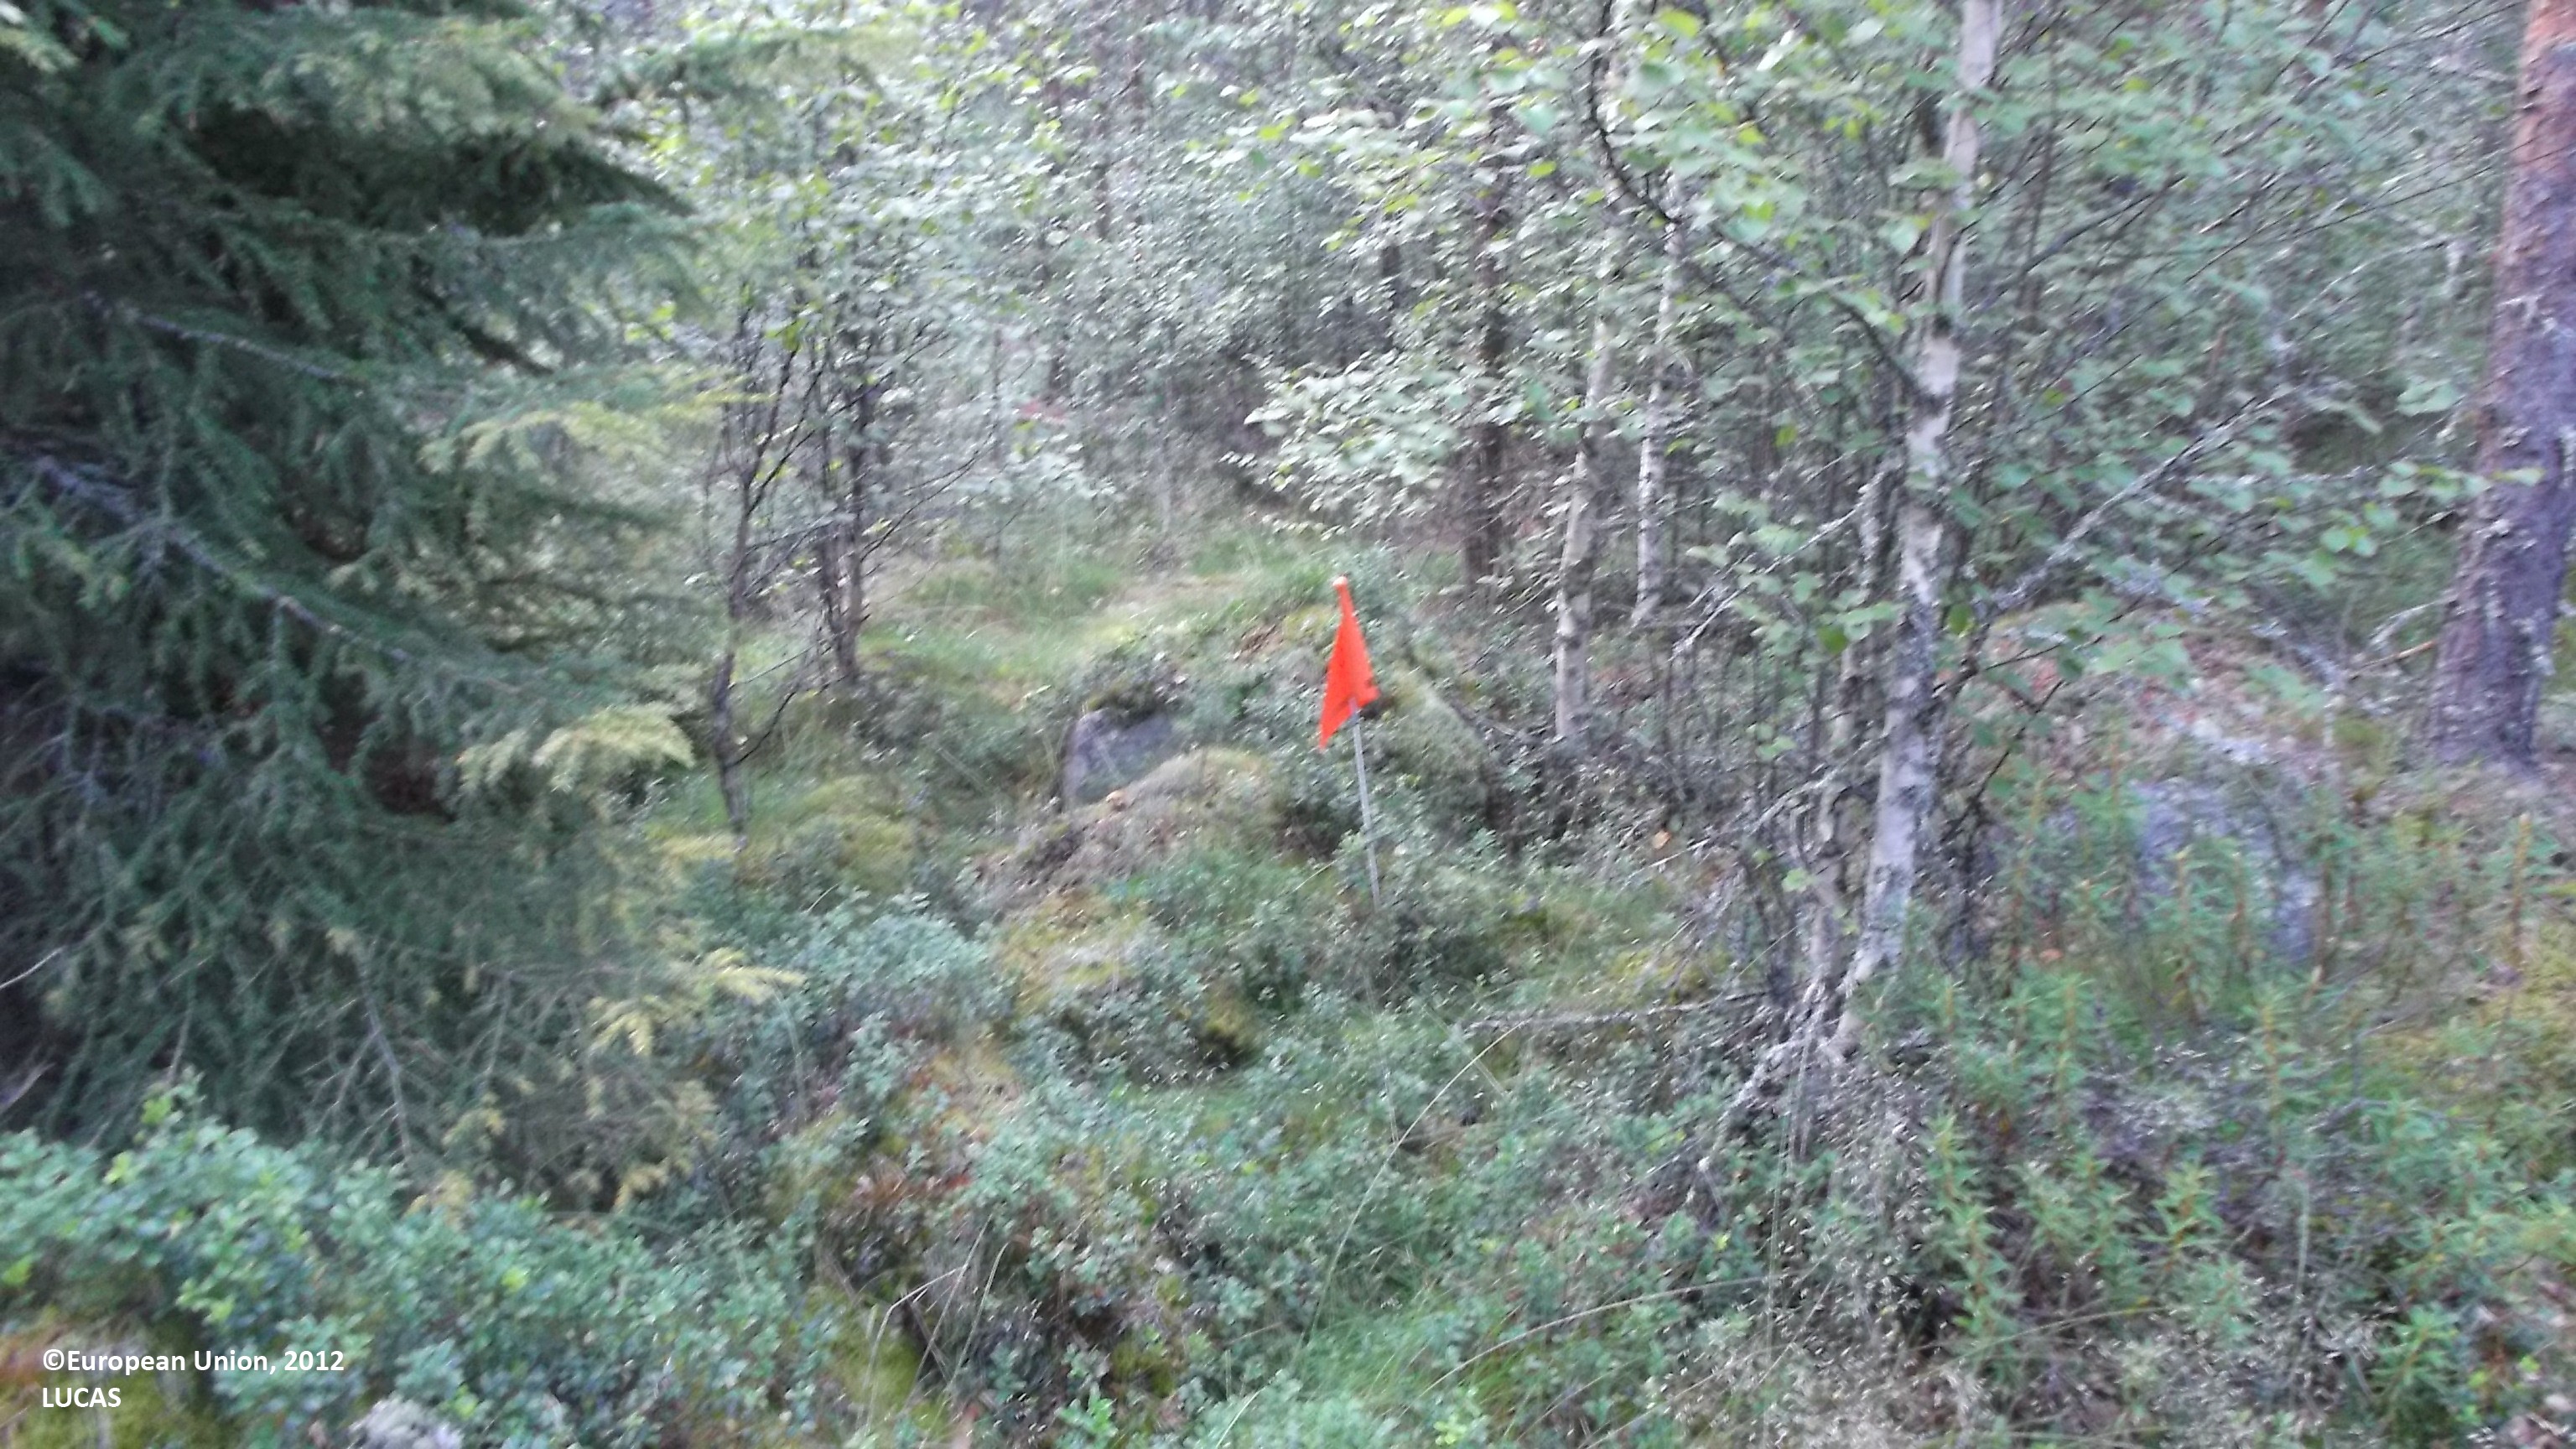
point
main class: Woodland
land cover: Pine dominated mixed woodland
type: boreal forest
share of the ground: 50 - 75 %
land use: Forestry
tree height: > 5 m
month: August
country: FI
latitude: 63.9640
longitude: 23.7217
